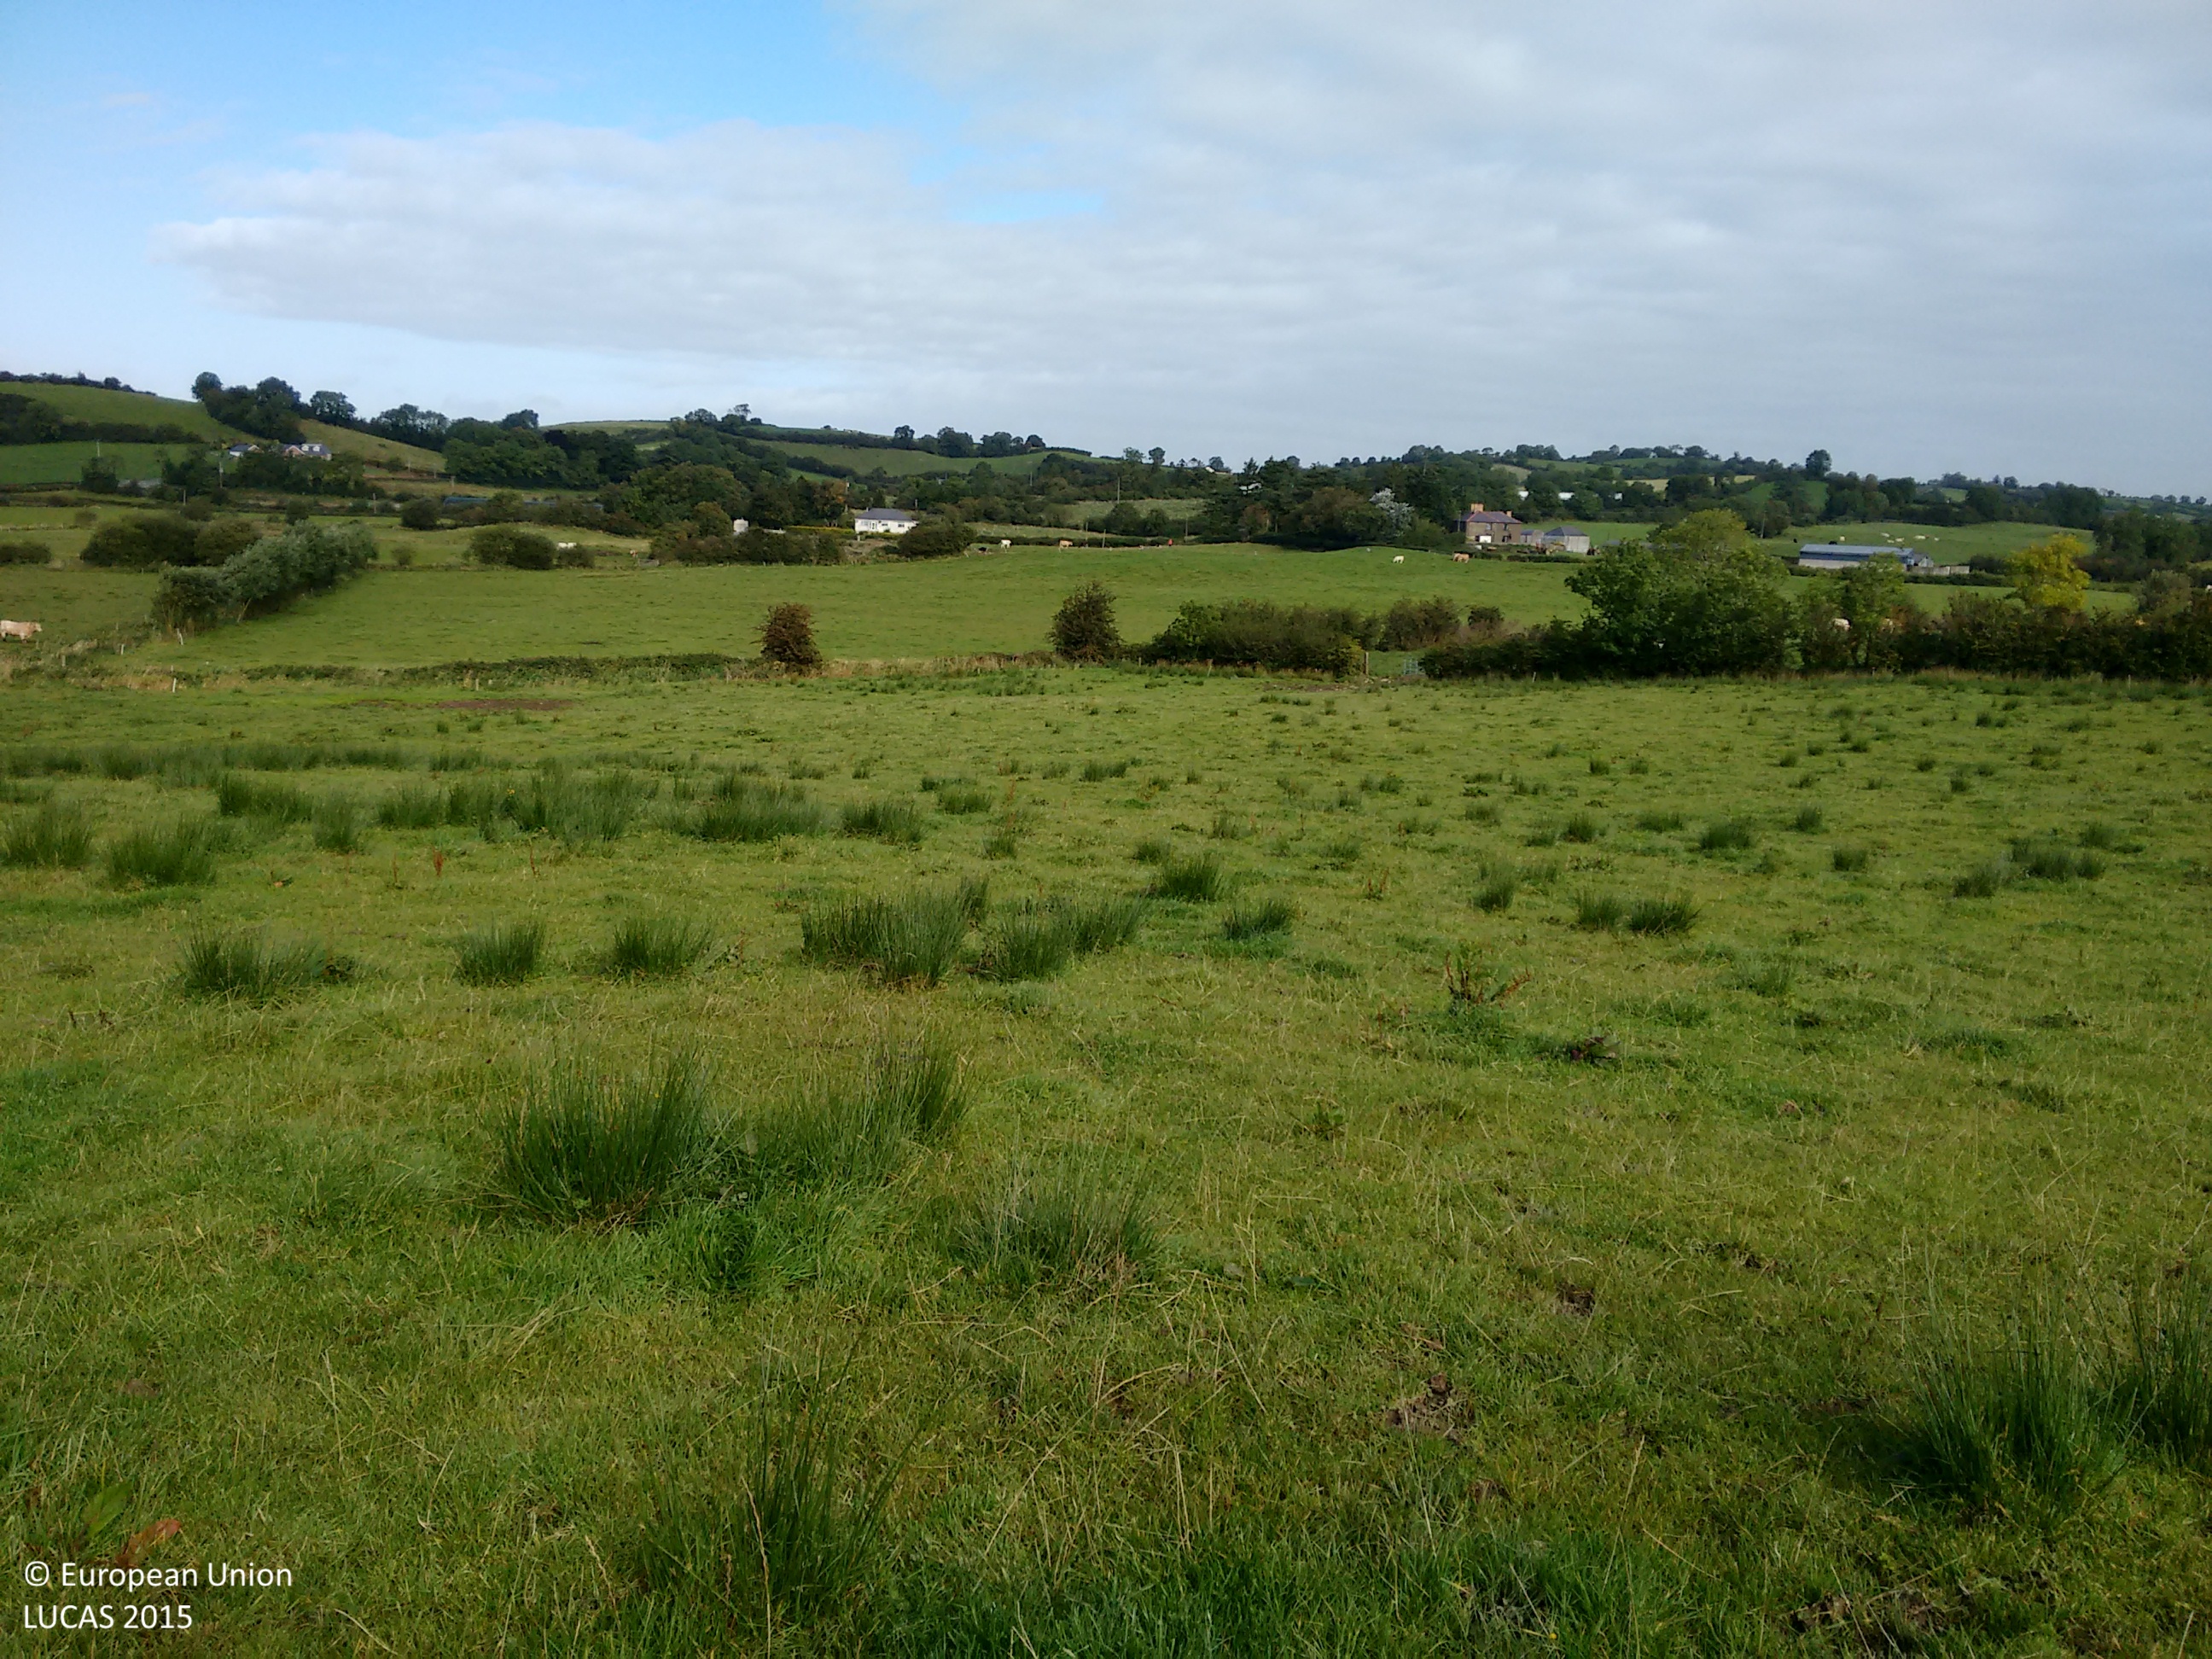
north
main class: Grassland
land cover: Grassland without tree/shrub cover
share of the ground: > 75 %
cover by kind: herbaceous plants 100 %
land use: Agriculture (excluding fallow land and kitchen gardens)
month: September
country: IE
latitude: 54.1340
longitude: -6.8961
